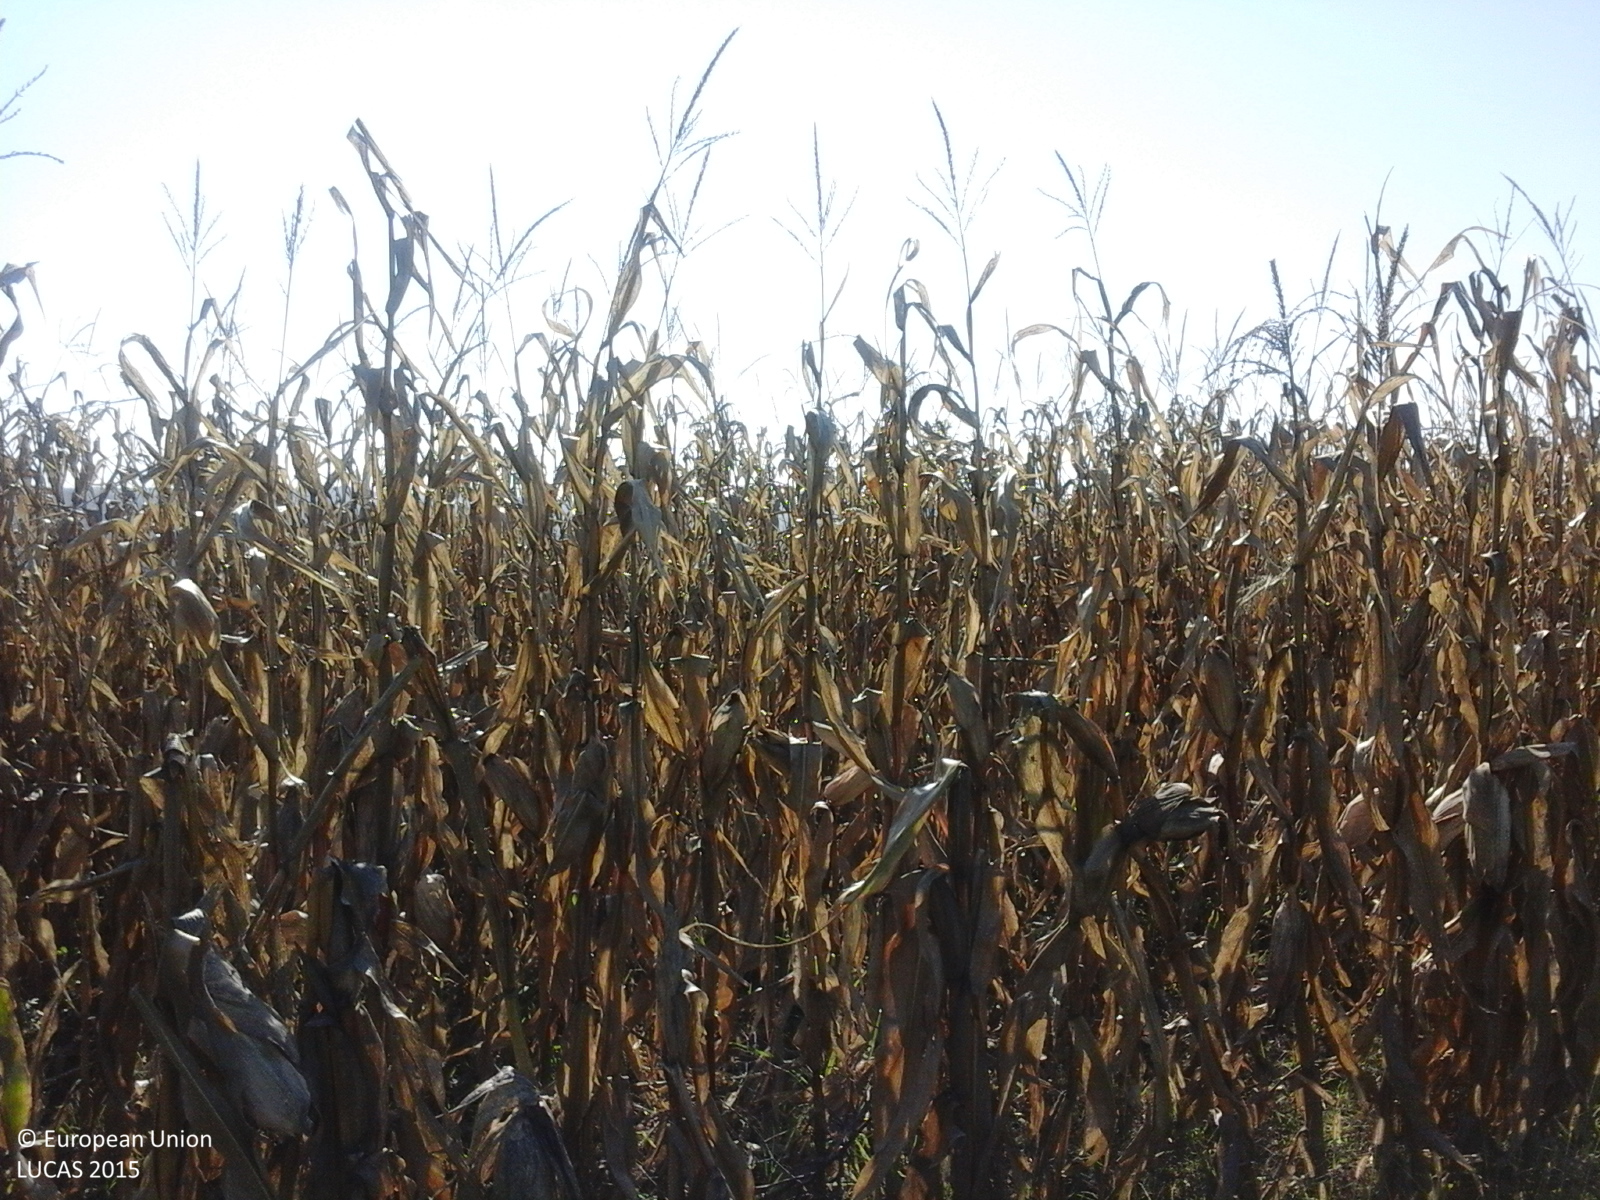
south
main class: Cropland
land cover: Maize
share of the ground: > 75 %
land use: Agriculture (excluding fallow land and kitchen gardens)
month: October
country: RO
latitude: 46.1203
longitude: 23.8532
